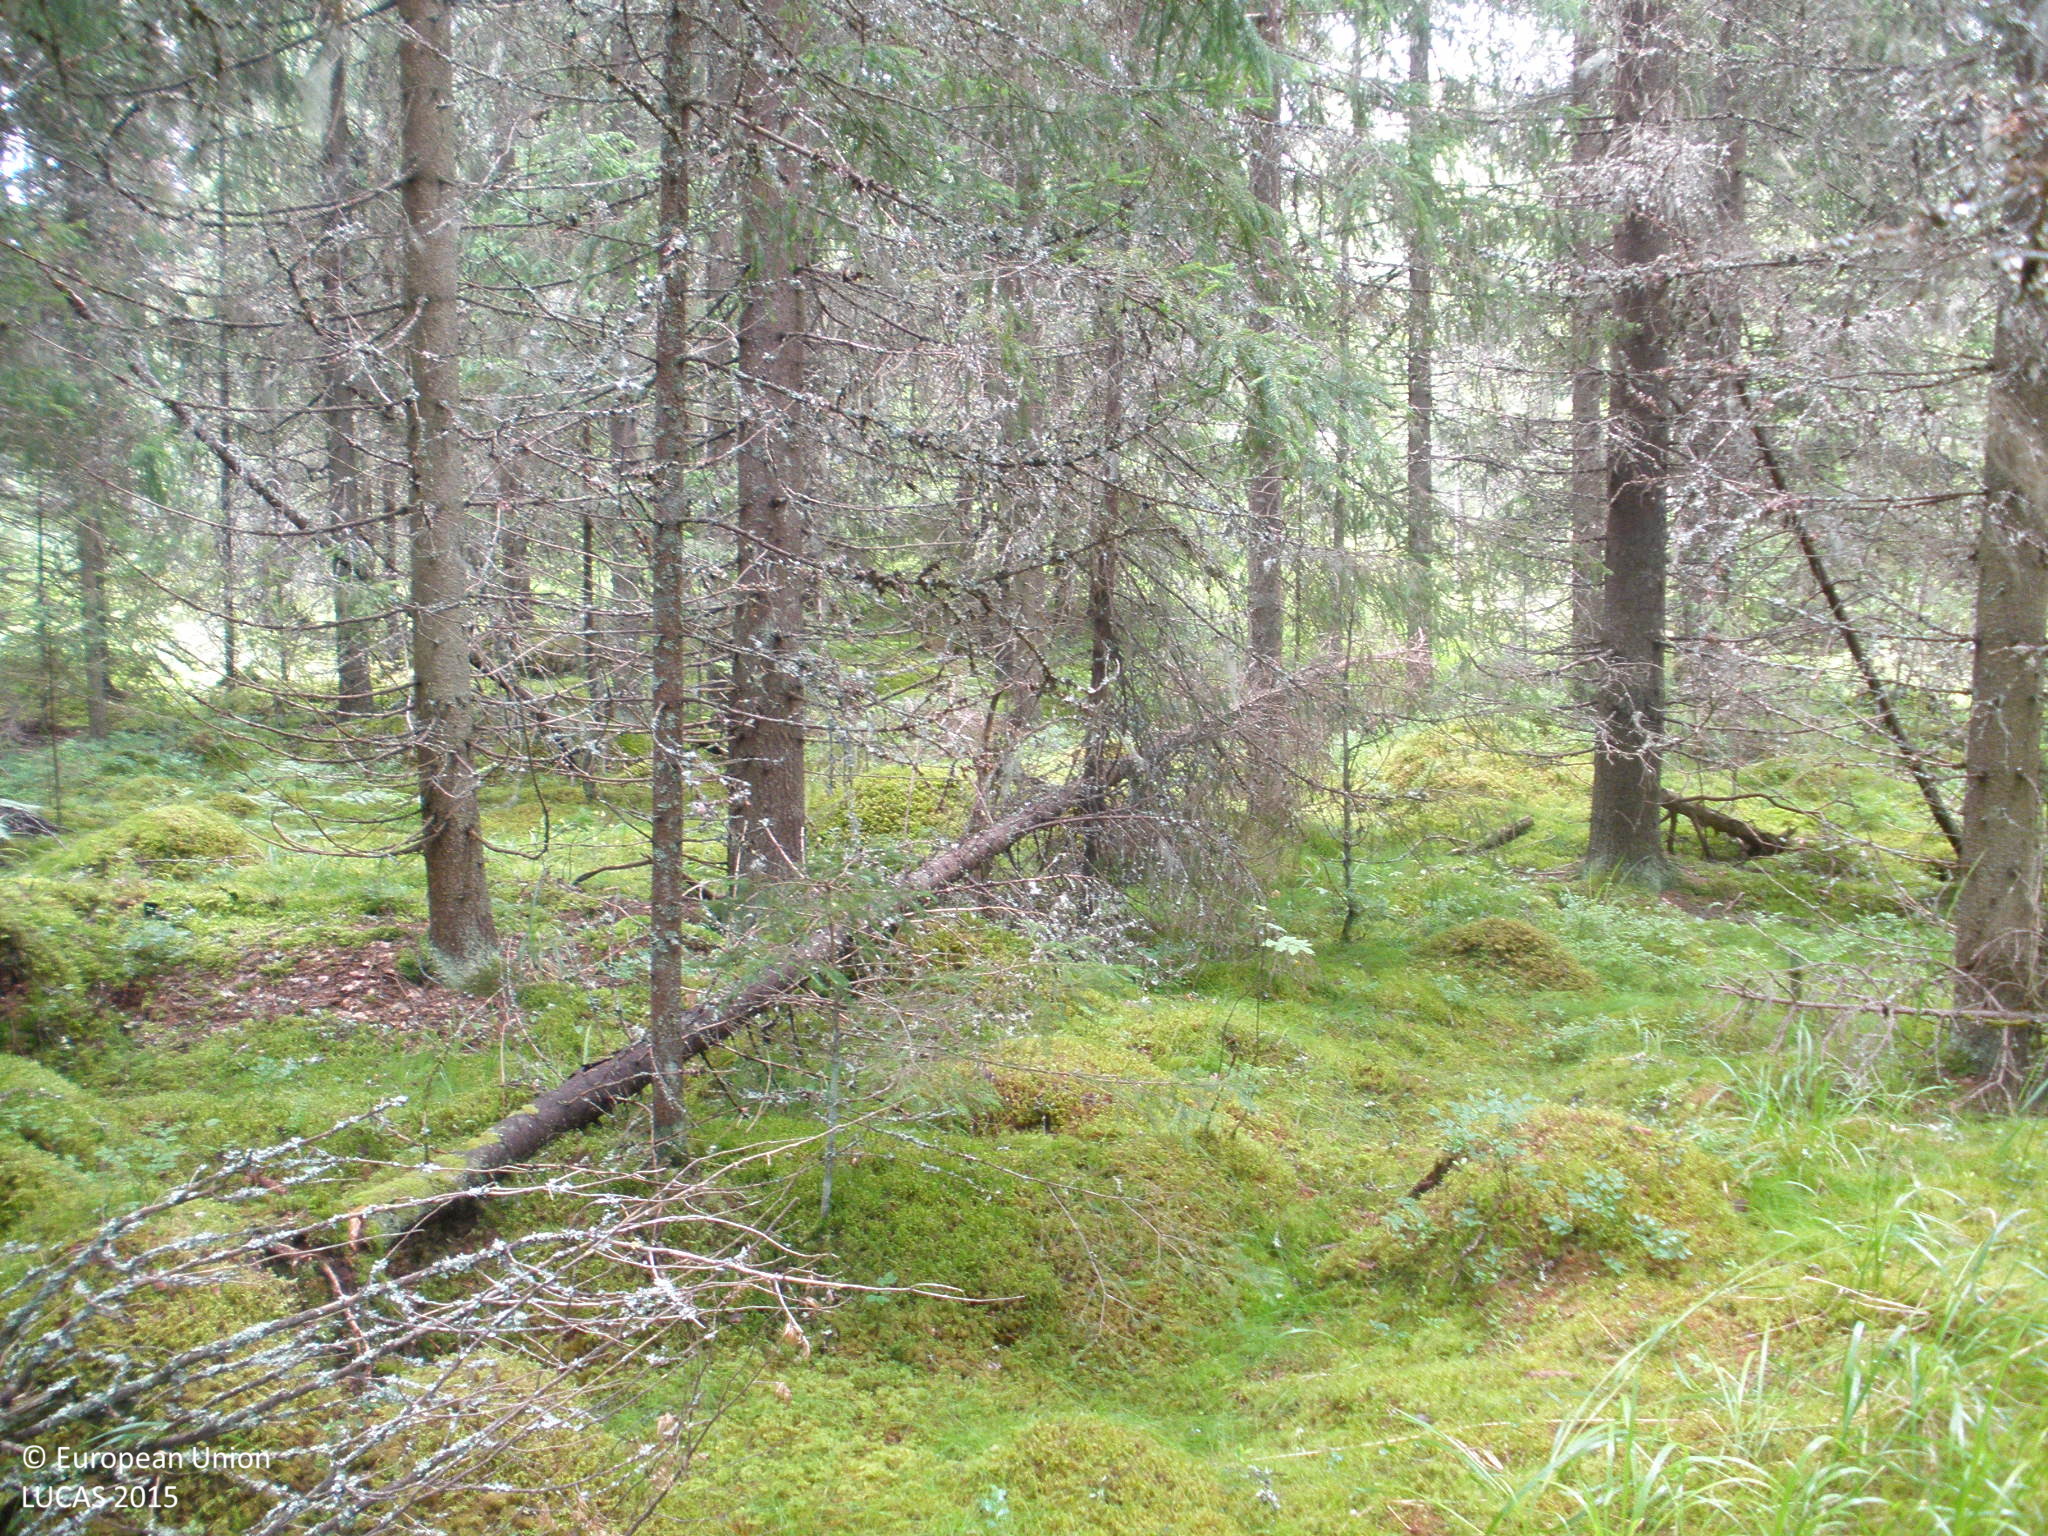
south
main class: Woodland
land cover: Spruce dominated coniferous woodland
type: boreal forest
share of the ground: > 75 %
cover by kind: coniferous forest trees 80 %, lichens and mosses 10 %, broadleaved forest trees 5 %, herbaceous plants 5 %
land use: Forestry
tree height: > 5 m
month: July
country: FI
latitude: 60.9902
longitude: 24.9940
